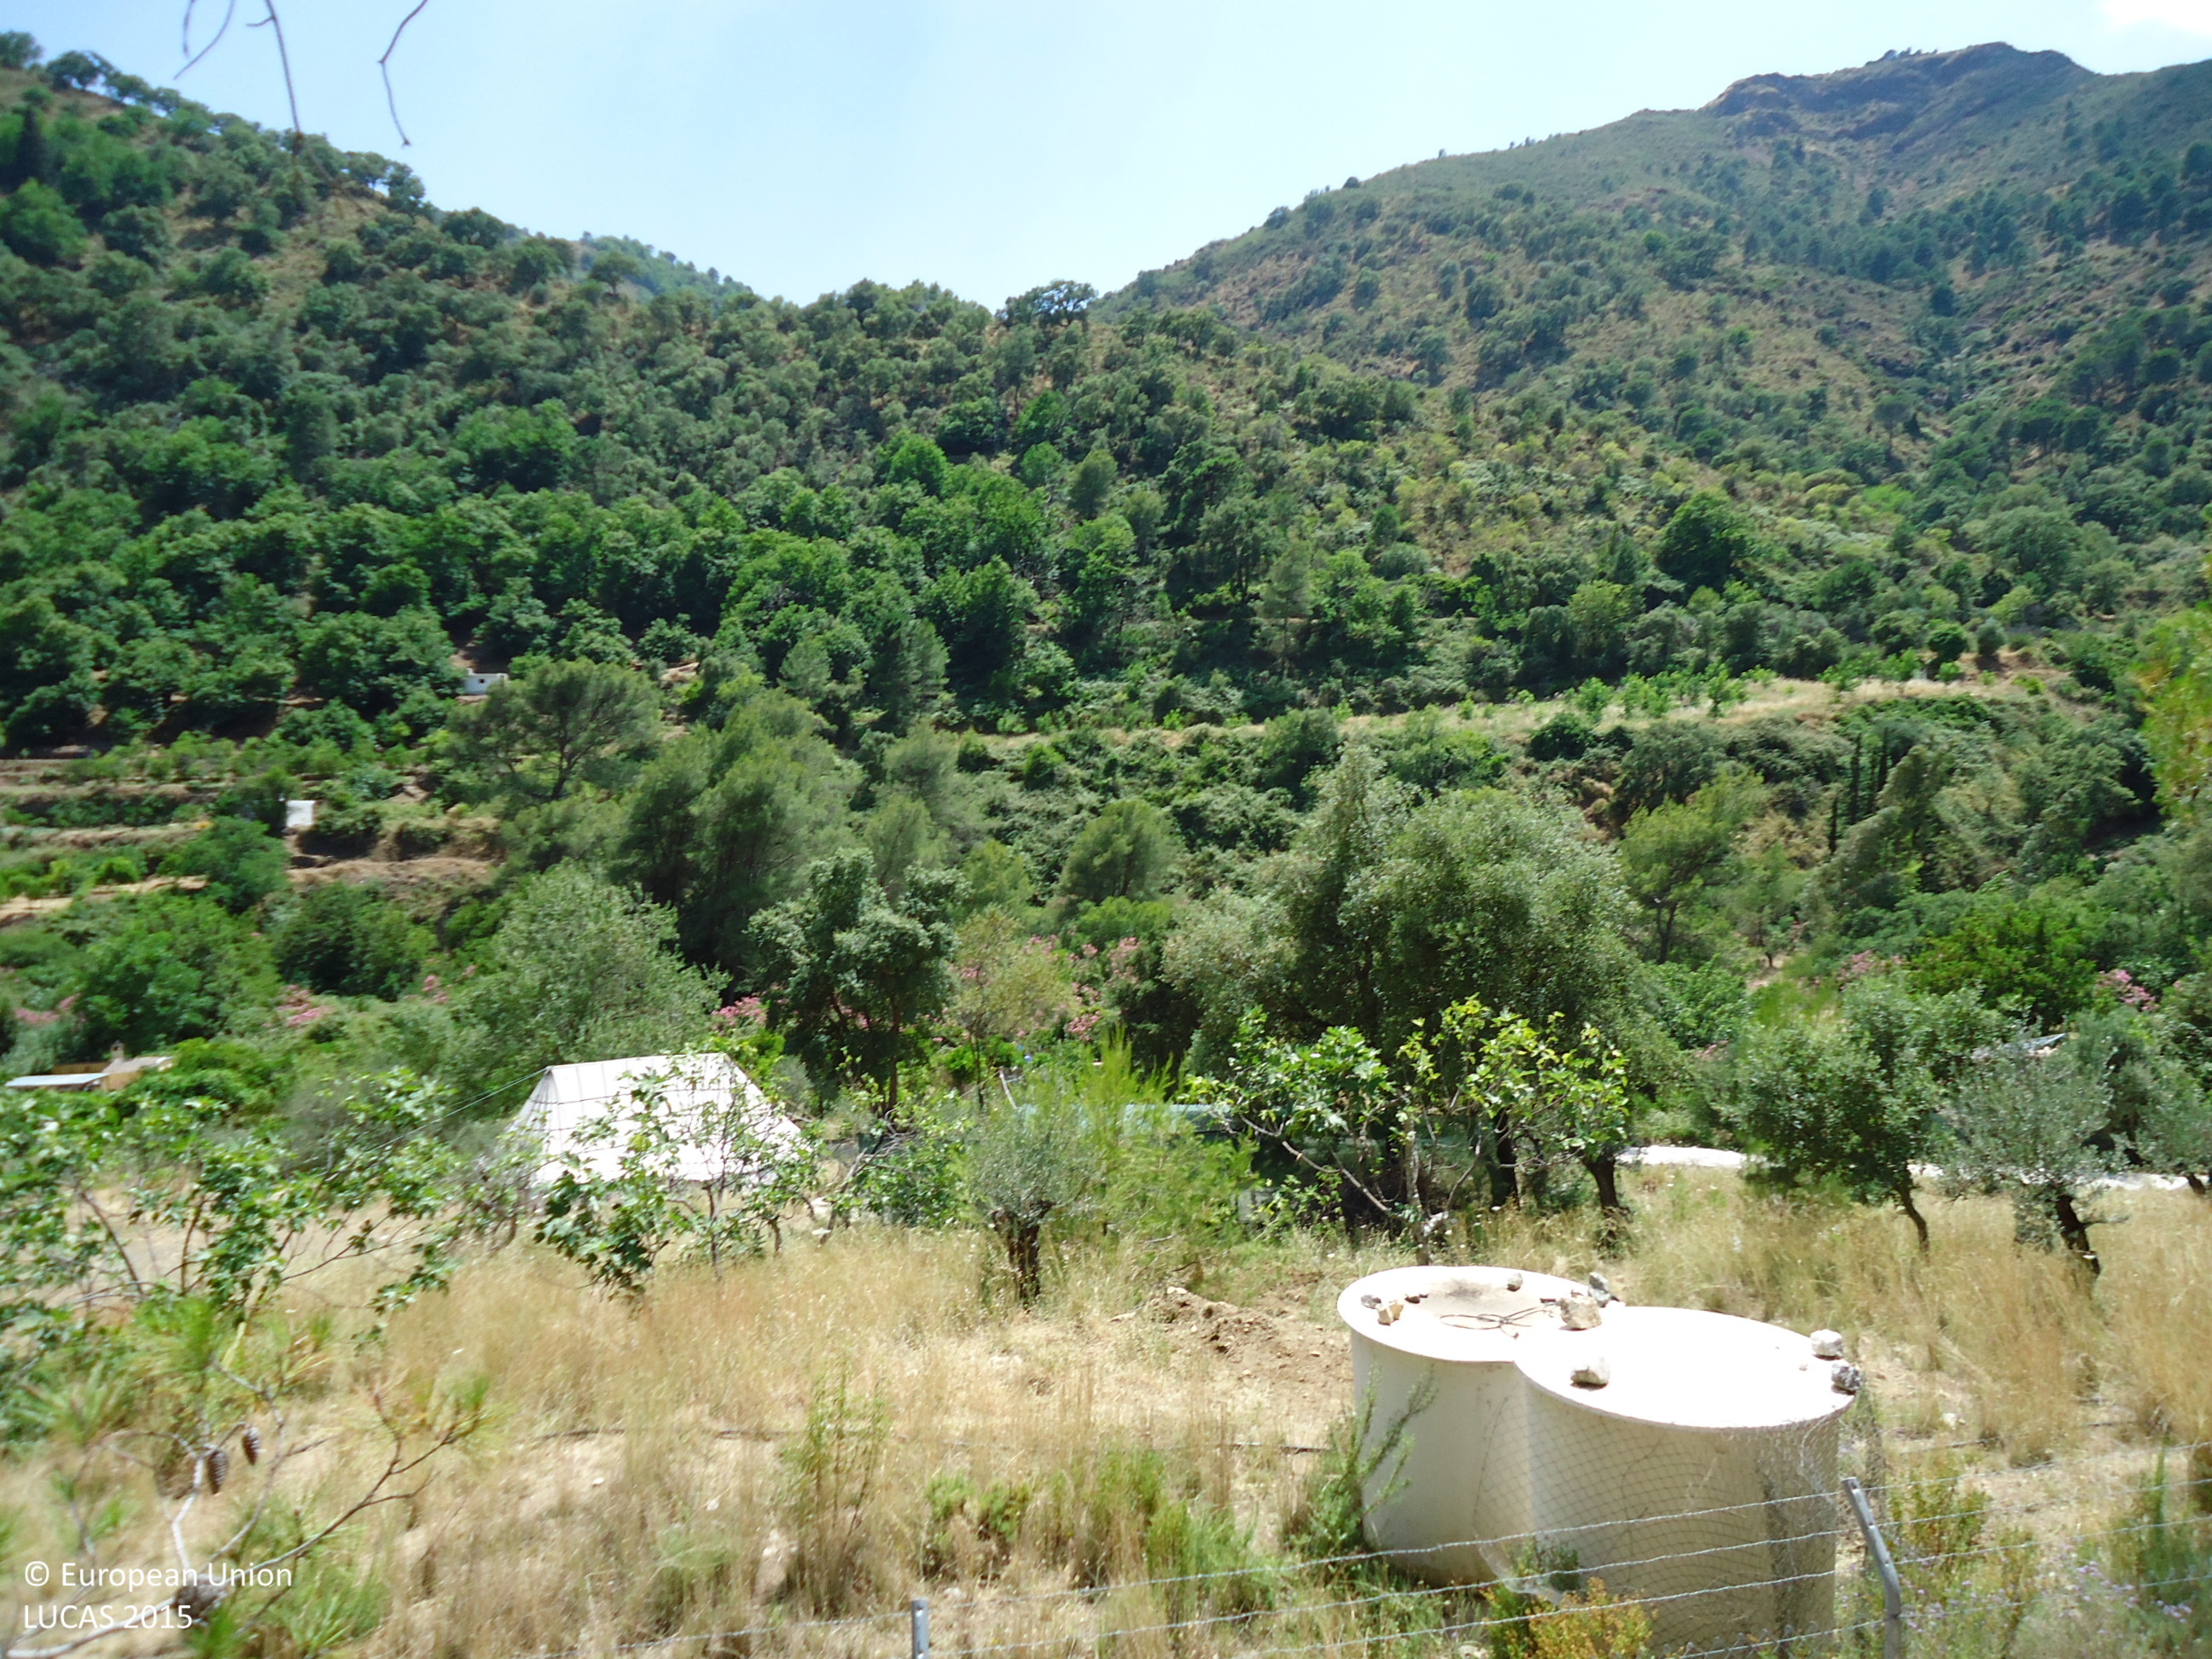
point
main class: Cropland
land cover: Olive groves
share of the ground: 10 - 25 %
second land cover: Spontaneously vegetated surfaces
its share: > 75 %
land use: Agriculture (excluding fallow land and kitchen gardens)
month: June
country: ES
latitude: 36.6896
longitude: -4.9362
